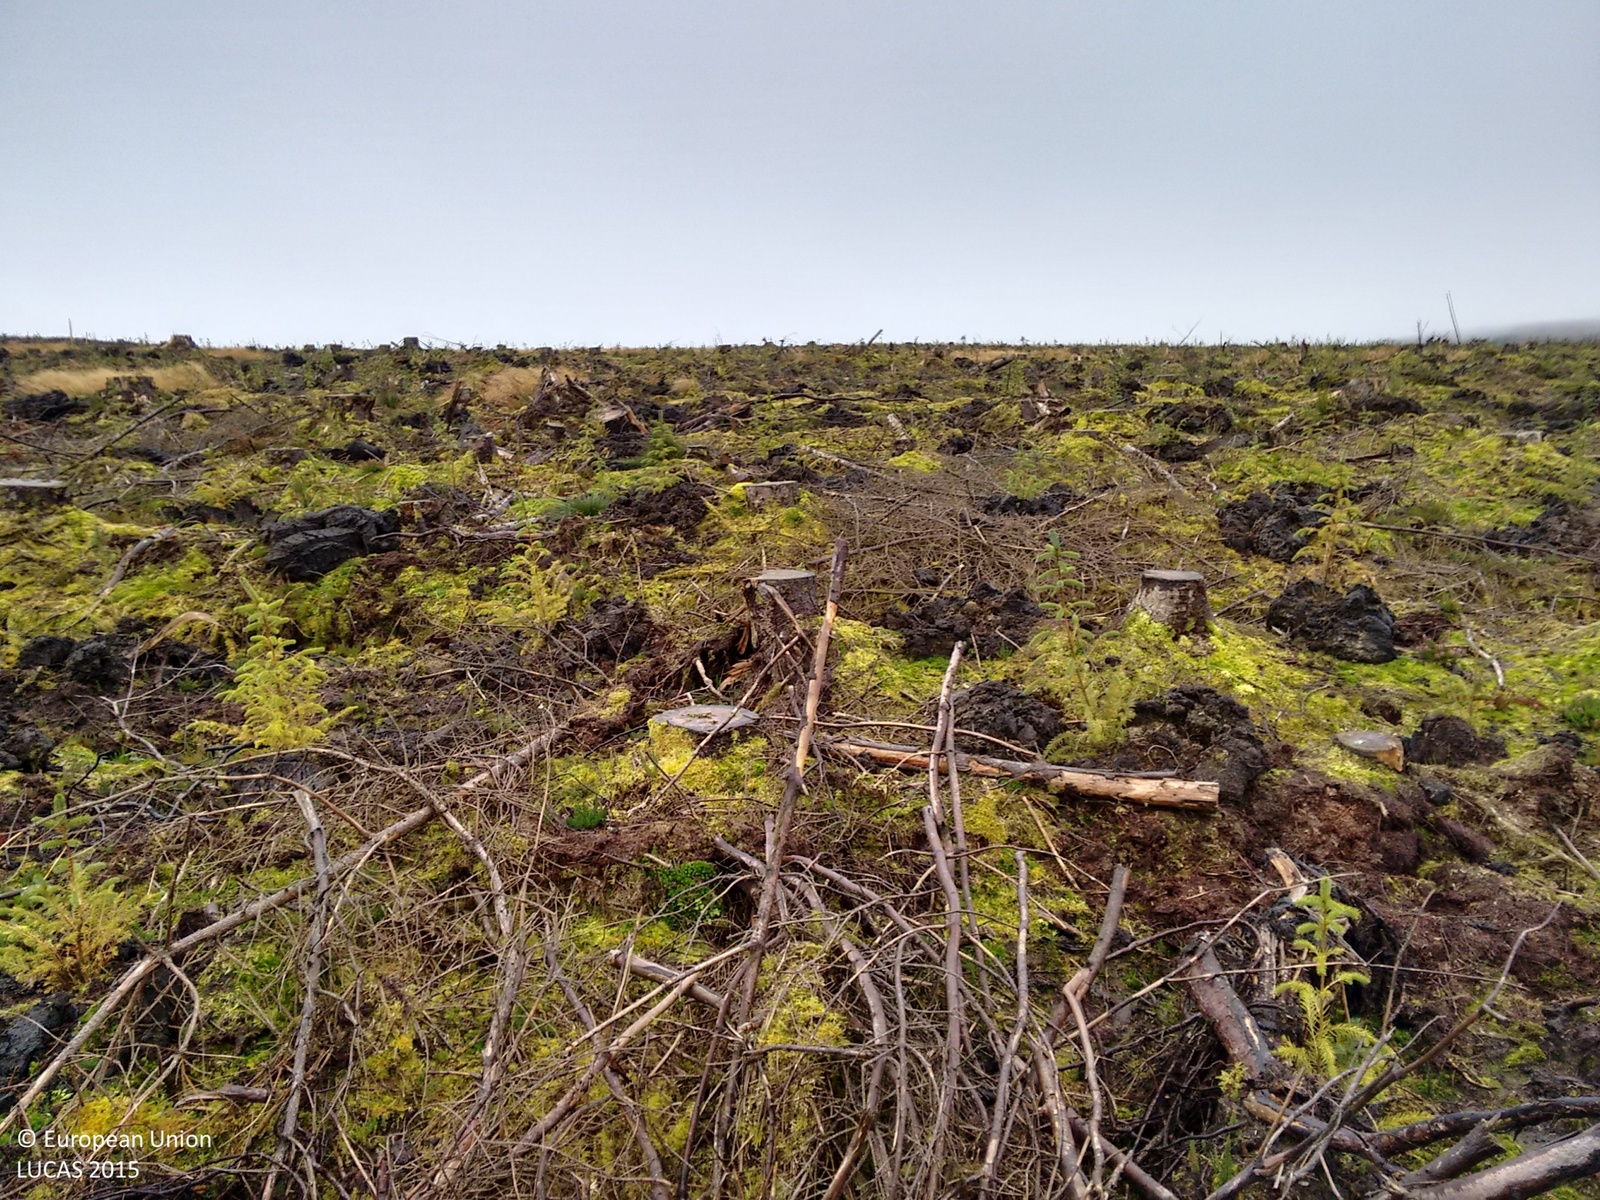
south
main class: Shrubland
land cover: Shrubland without tree cover
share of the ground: > 75 %
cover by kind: shrubs 80 %, lichens and mosses 20 %
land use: Forestry
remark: Clear cut
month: October
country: GB
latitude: 54.5785
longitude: -7.5306
